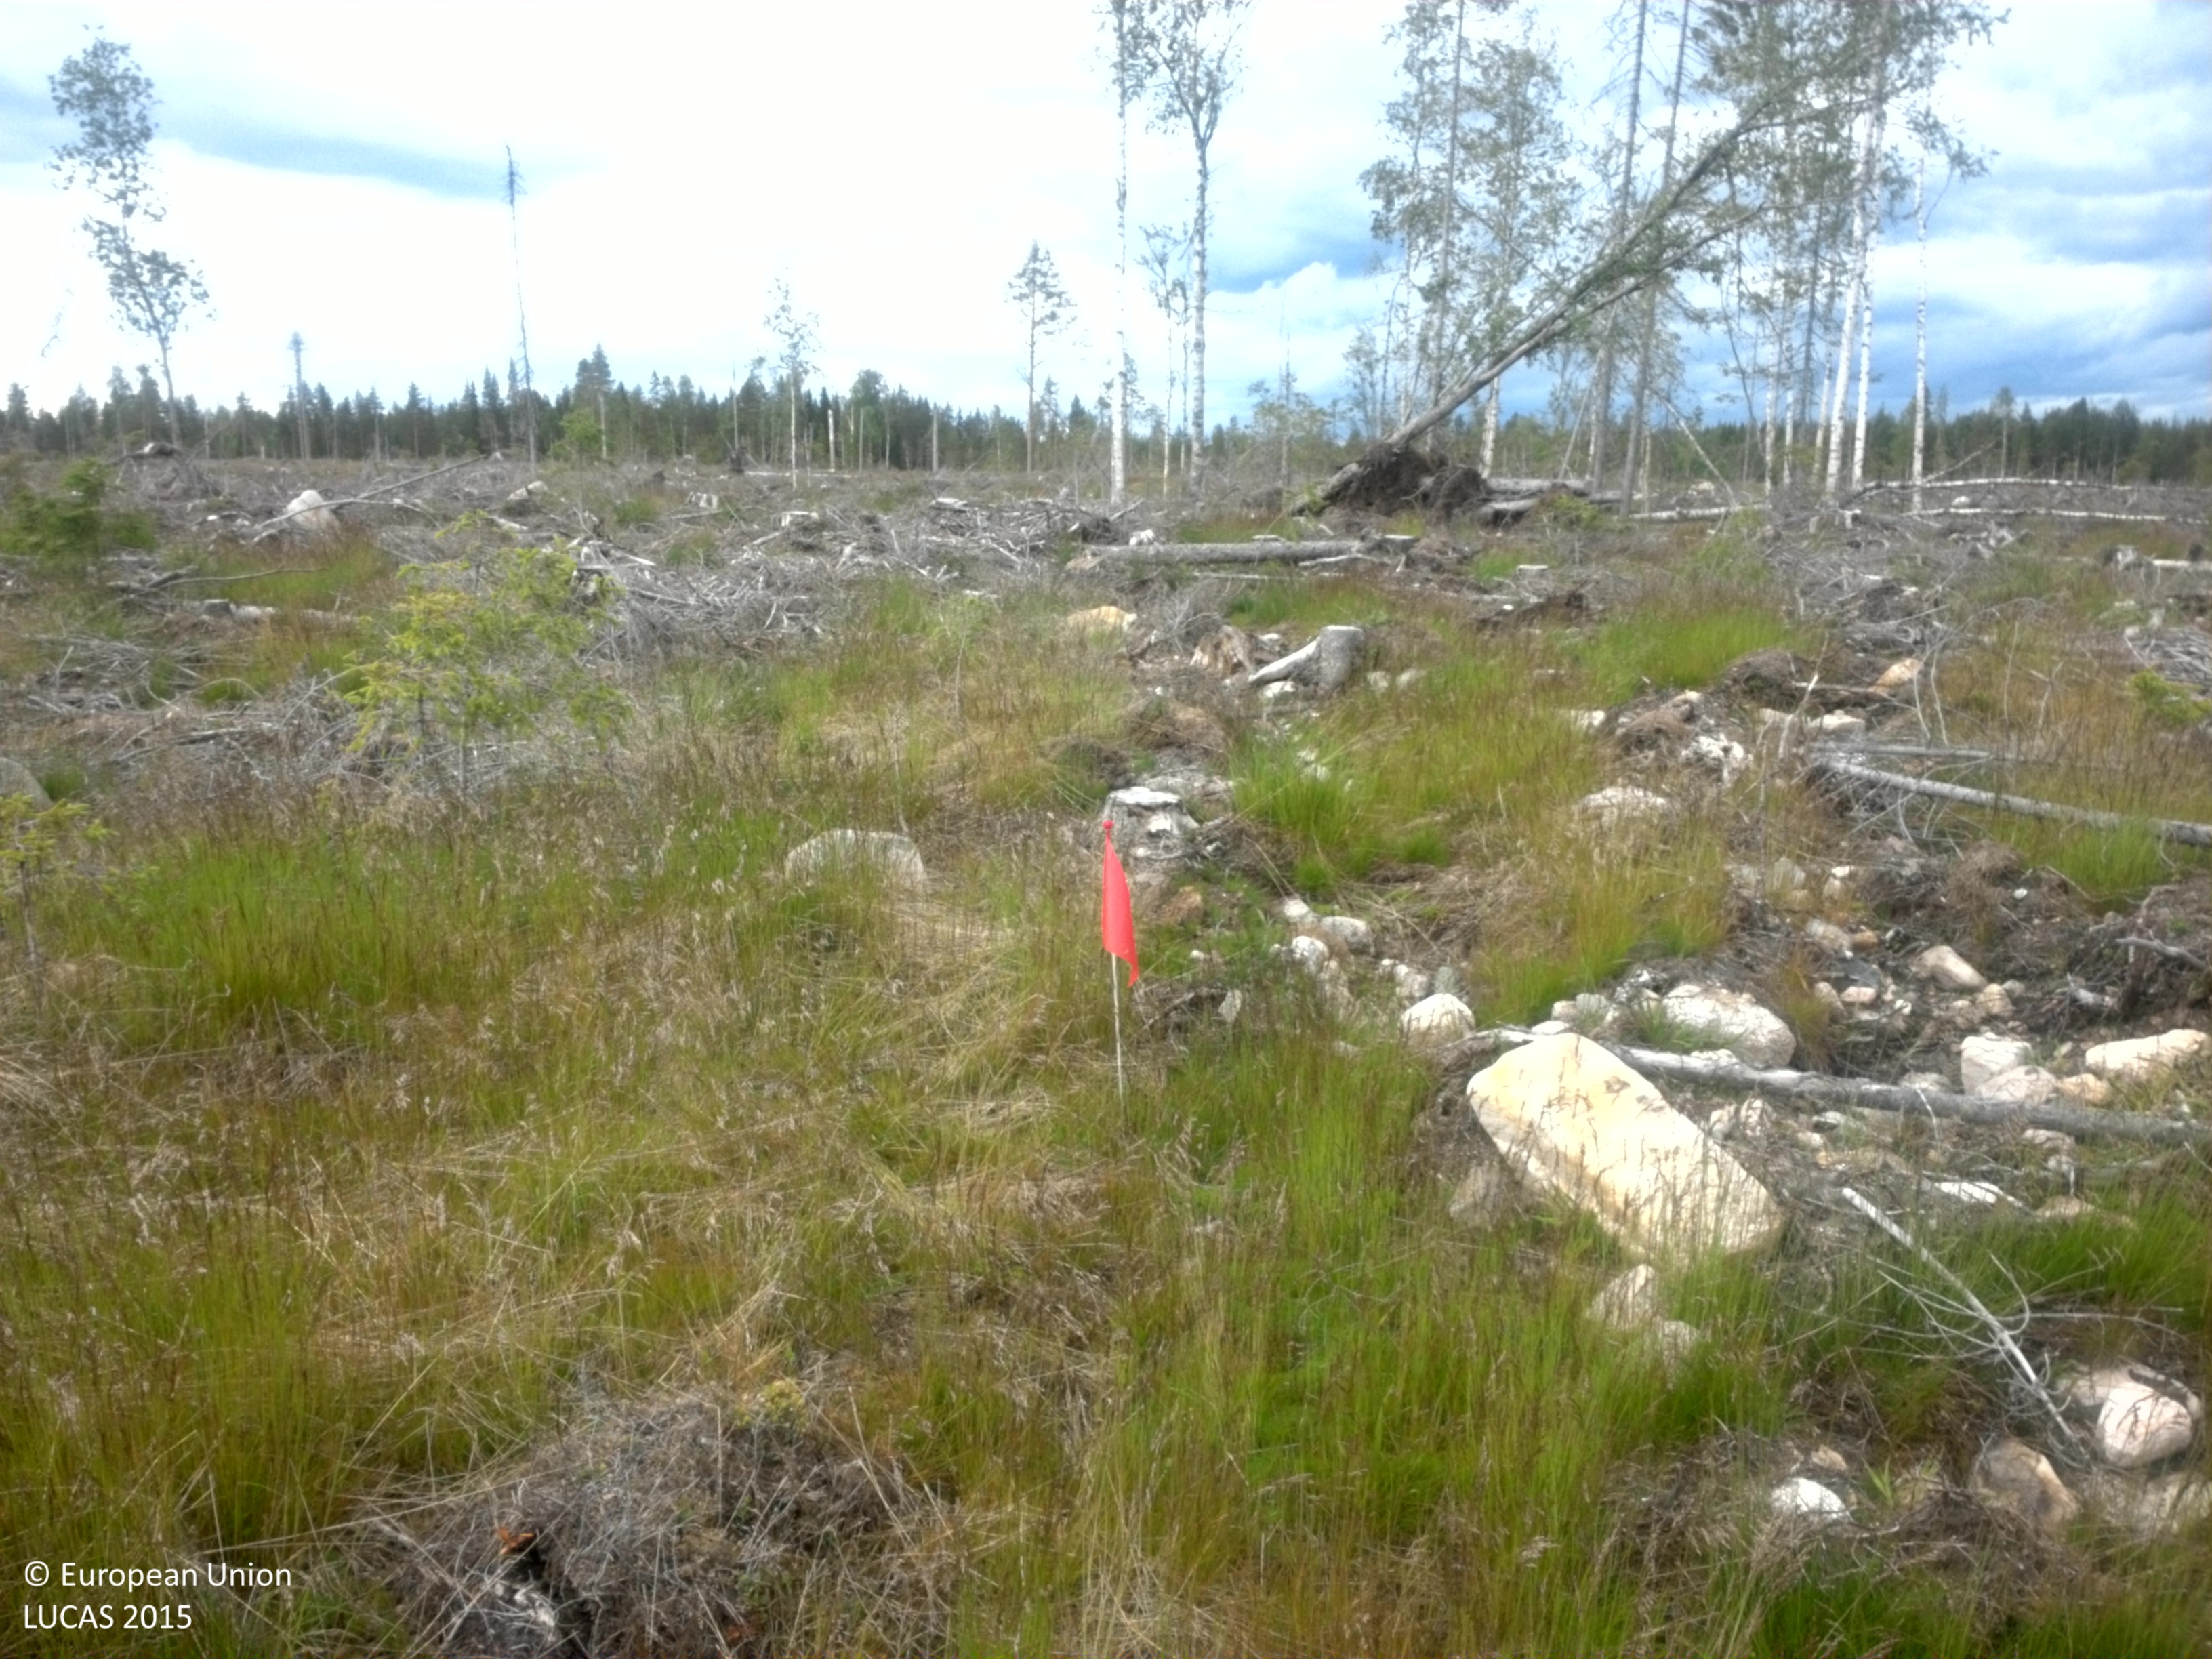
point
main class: Grassland
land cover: Grassland with sparse tree/shrub cover
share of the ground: > 75 %
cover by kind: herbaceous plants 65 %, unconsolidated bare surface 20 %, broadleaved forest trees 5 %, shrubs 5 %, consolidated bare surface 5 %
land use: Forestry
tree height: > 5 m
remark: Clear cut
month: July
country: SE
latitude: 64.6975
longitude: 20.3544
